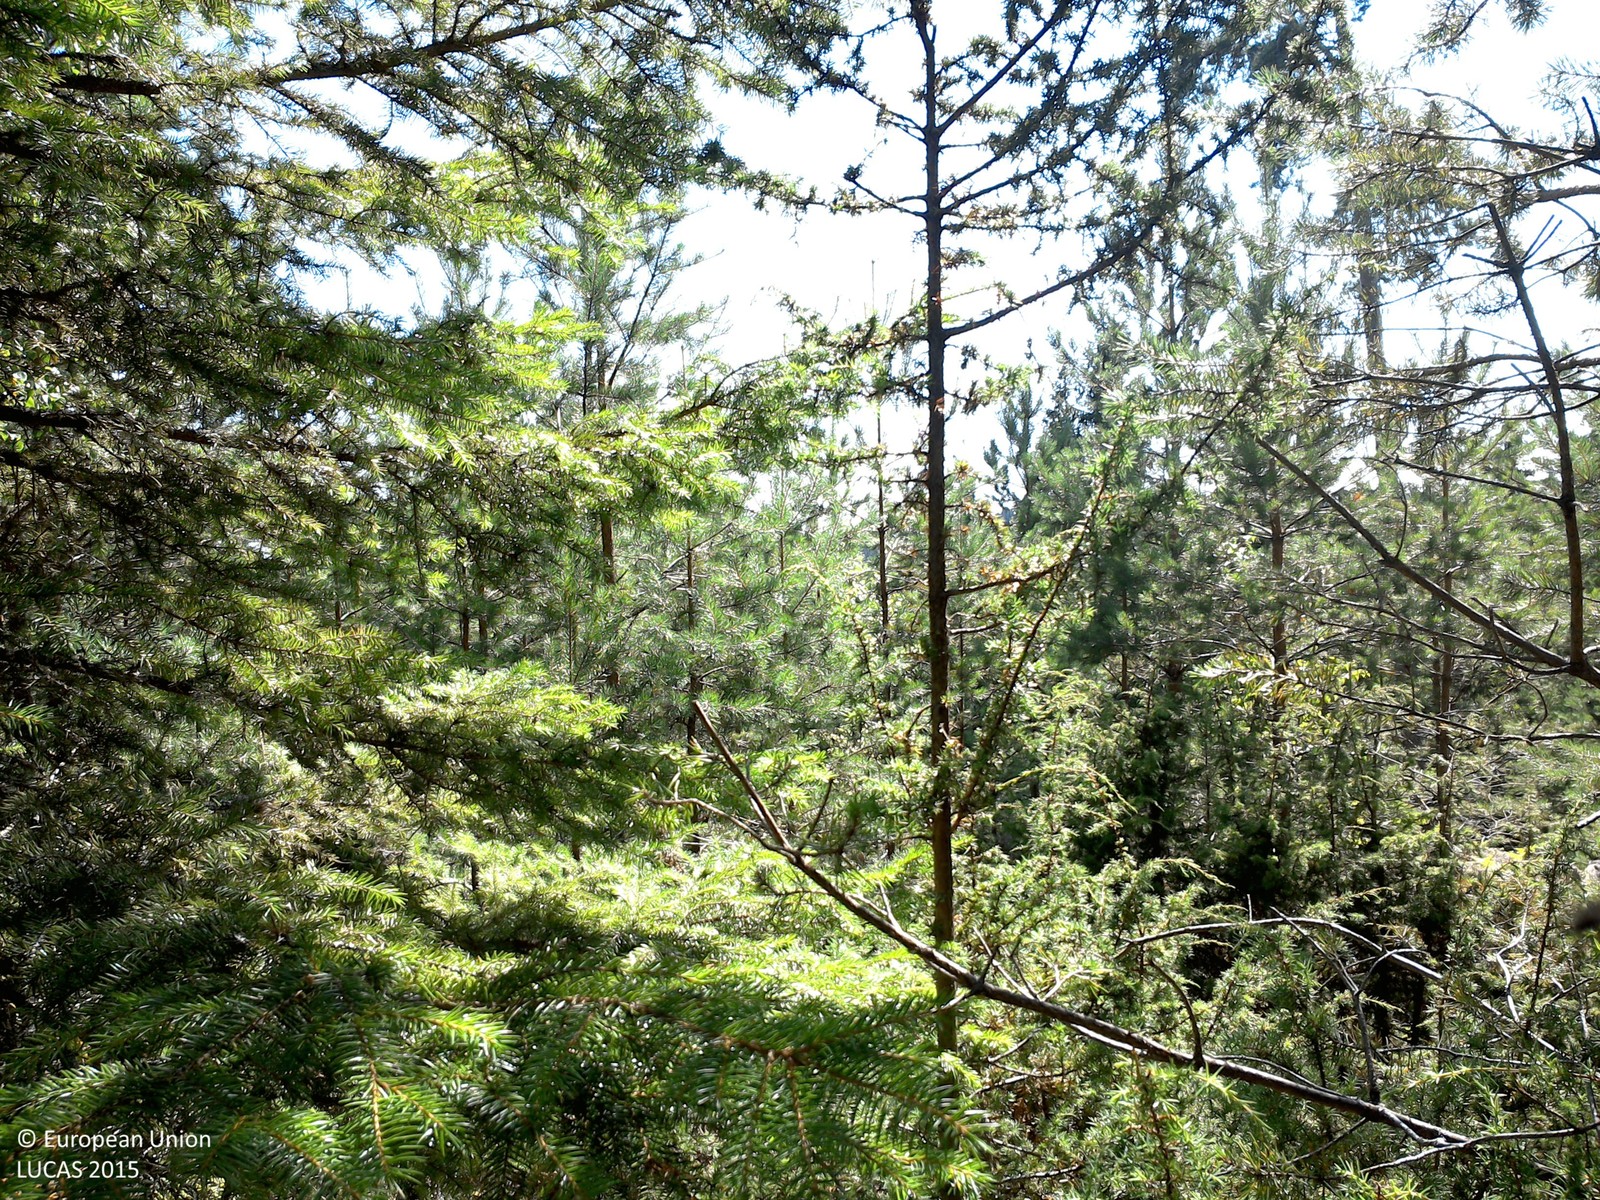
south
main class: Woodland
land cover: Pine dominated coniferous woodland
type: boreal forest
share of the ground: 50 - 75 %
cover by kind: coniferous forest trees 60 %, herbaceous plants 40 %
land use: Forestry
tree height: > 5 m
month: August
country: SE
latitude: 57.8652
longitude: 15.6766
